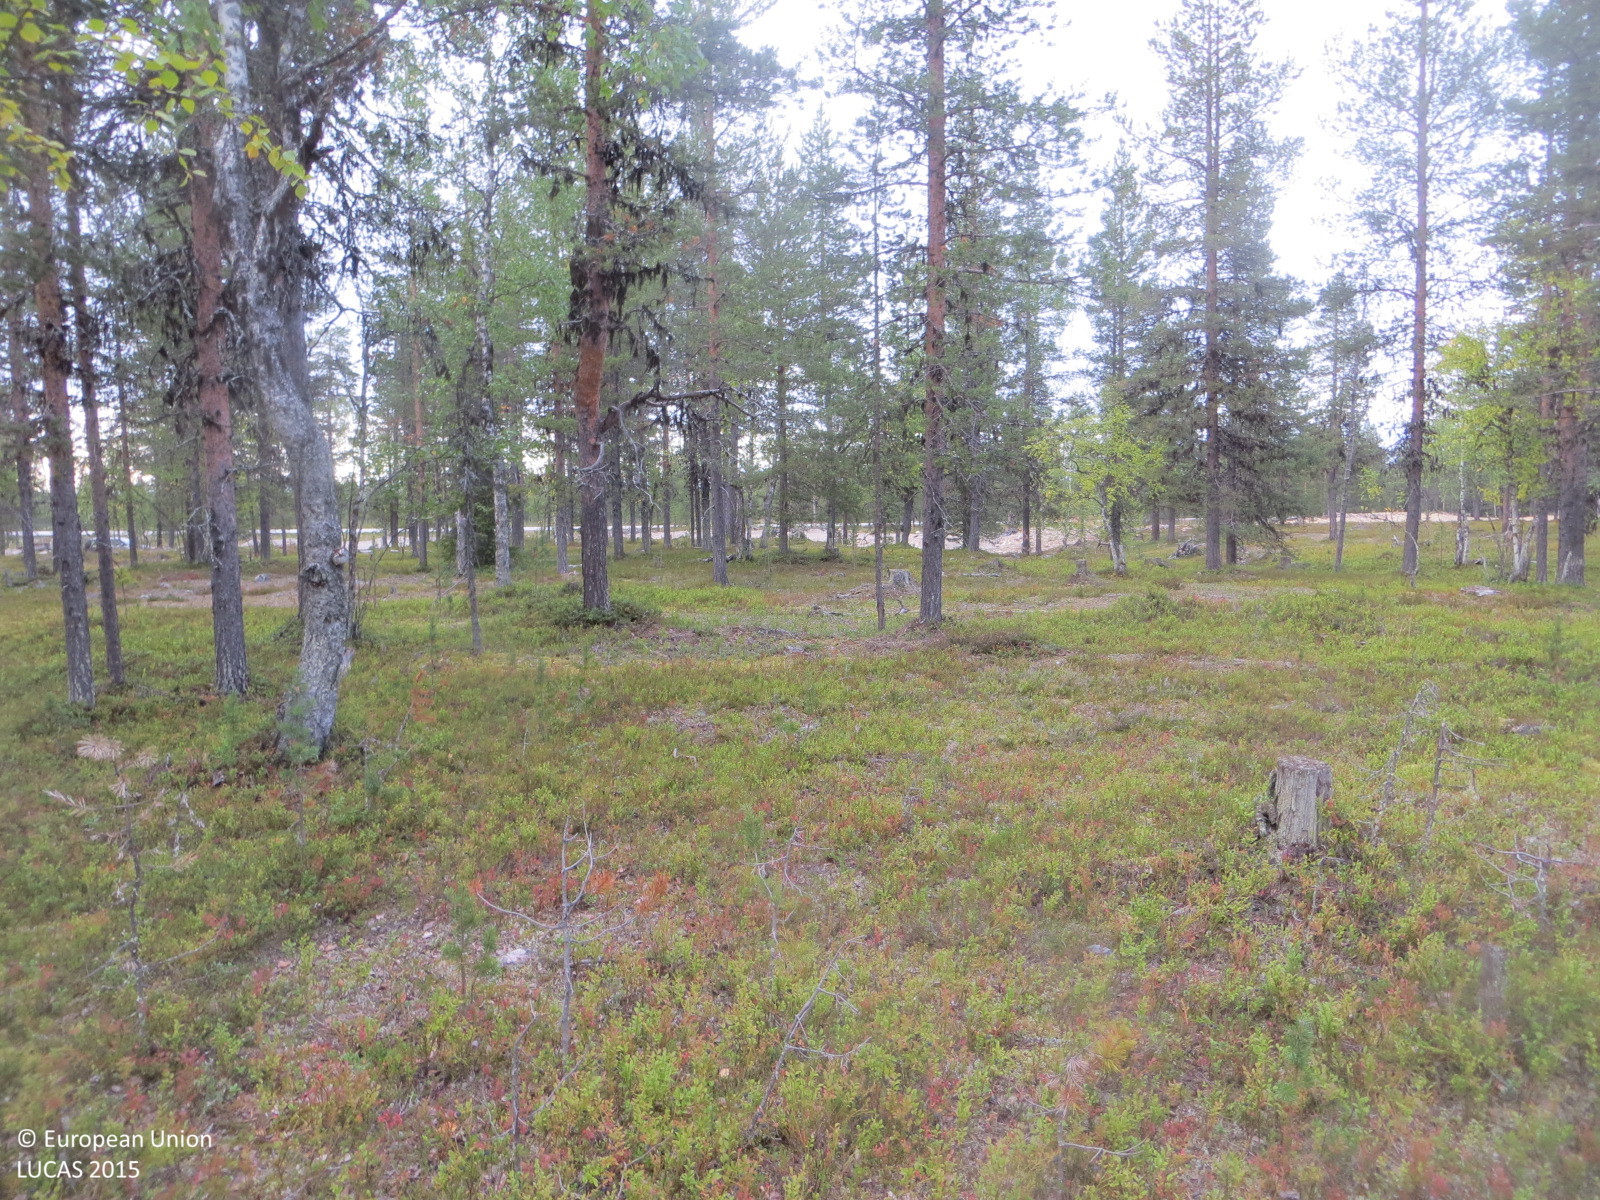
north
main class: Woodland
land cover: Pine dominated mixed woodland
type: boreal forest
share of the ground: 25 - 50 %
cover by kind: shrubs 60 %, coniferous forest trees 30 %, broadleaved forest trees 10 %
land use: Forestry
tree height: > 5 m
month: September
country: FI
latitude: 67.9250
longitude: 24.4490
